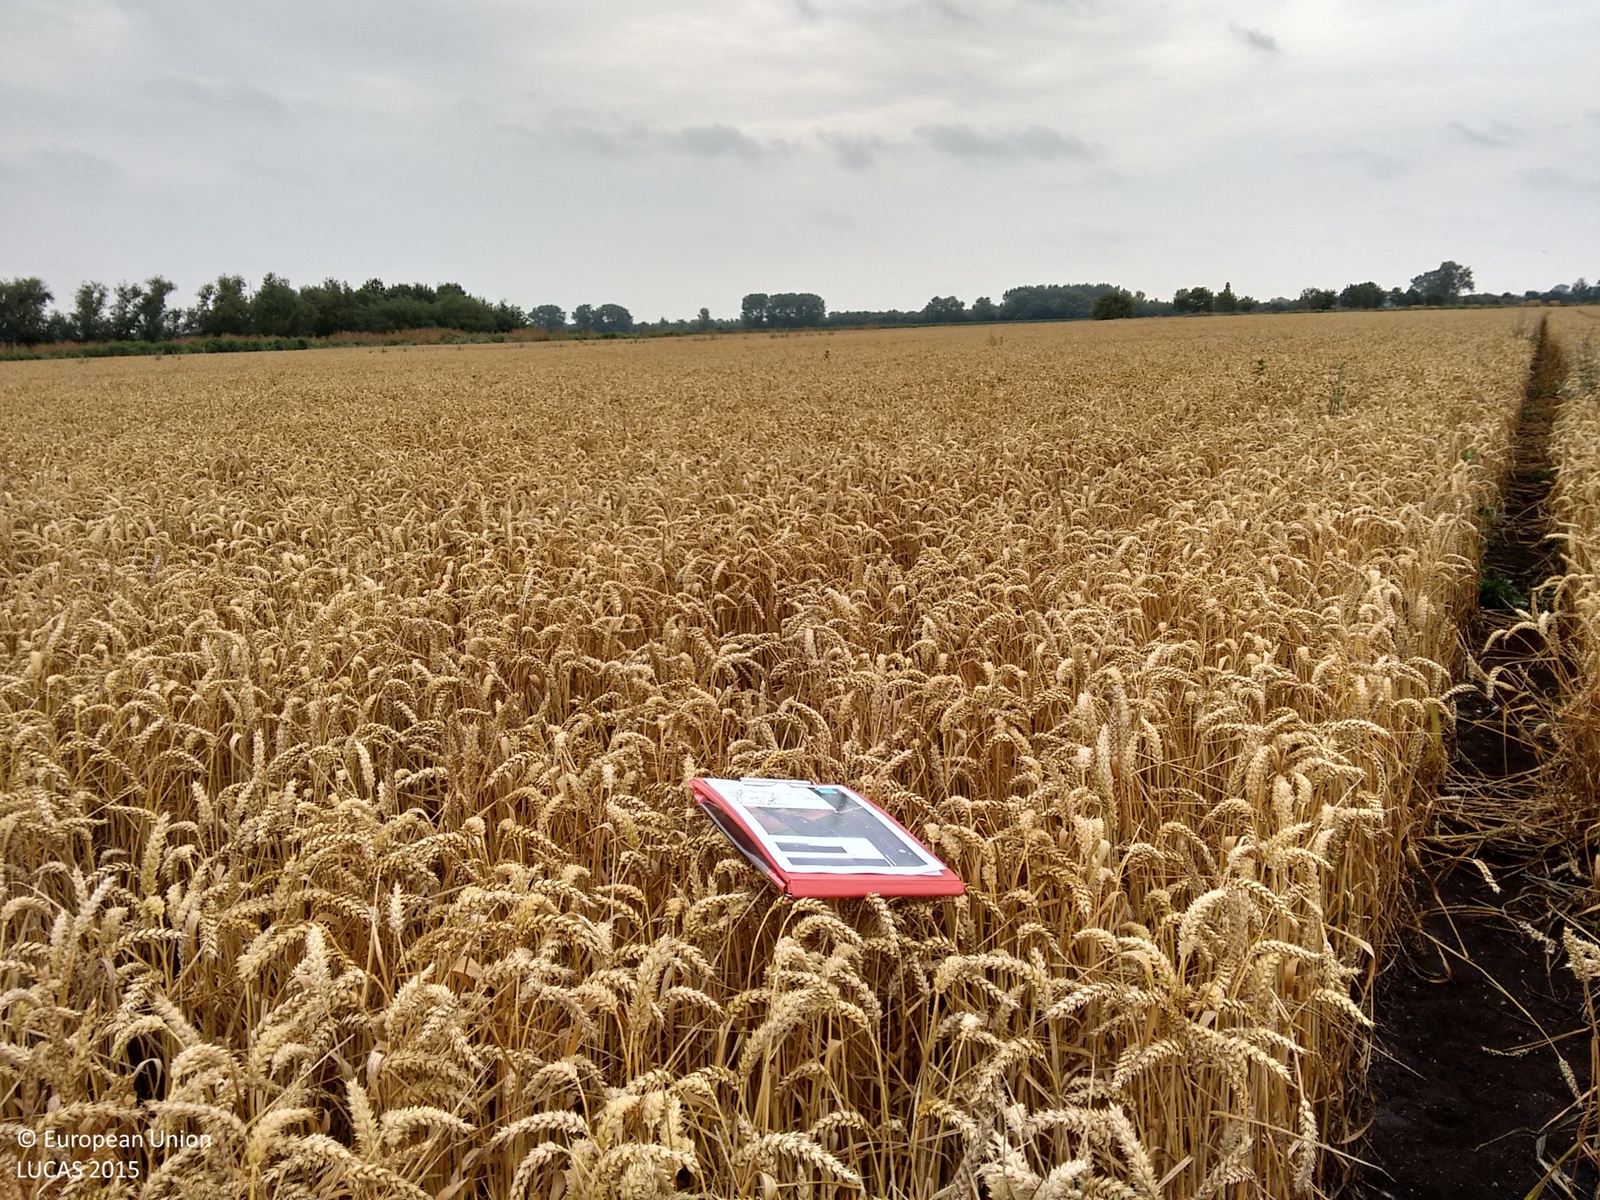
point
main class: Cropland
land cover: Common wheat
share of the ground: > 75 %
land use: Agriculture (excluding fallow land and kitchen gardens)
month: August
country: GB
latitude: 52.3485
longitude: 0.3850
